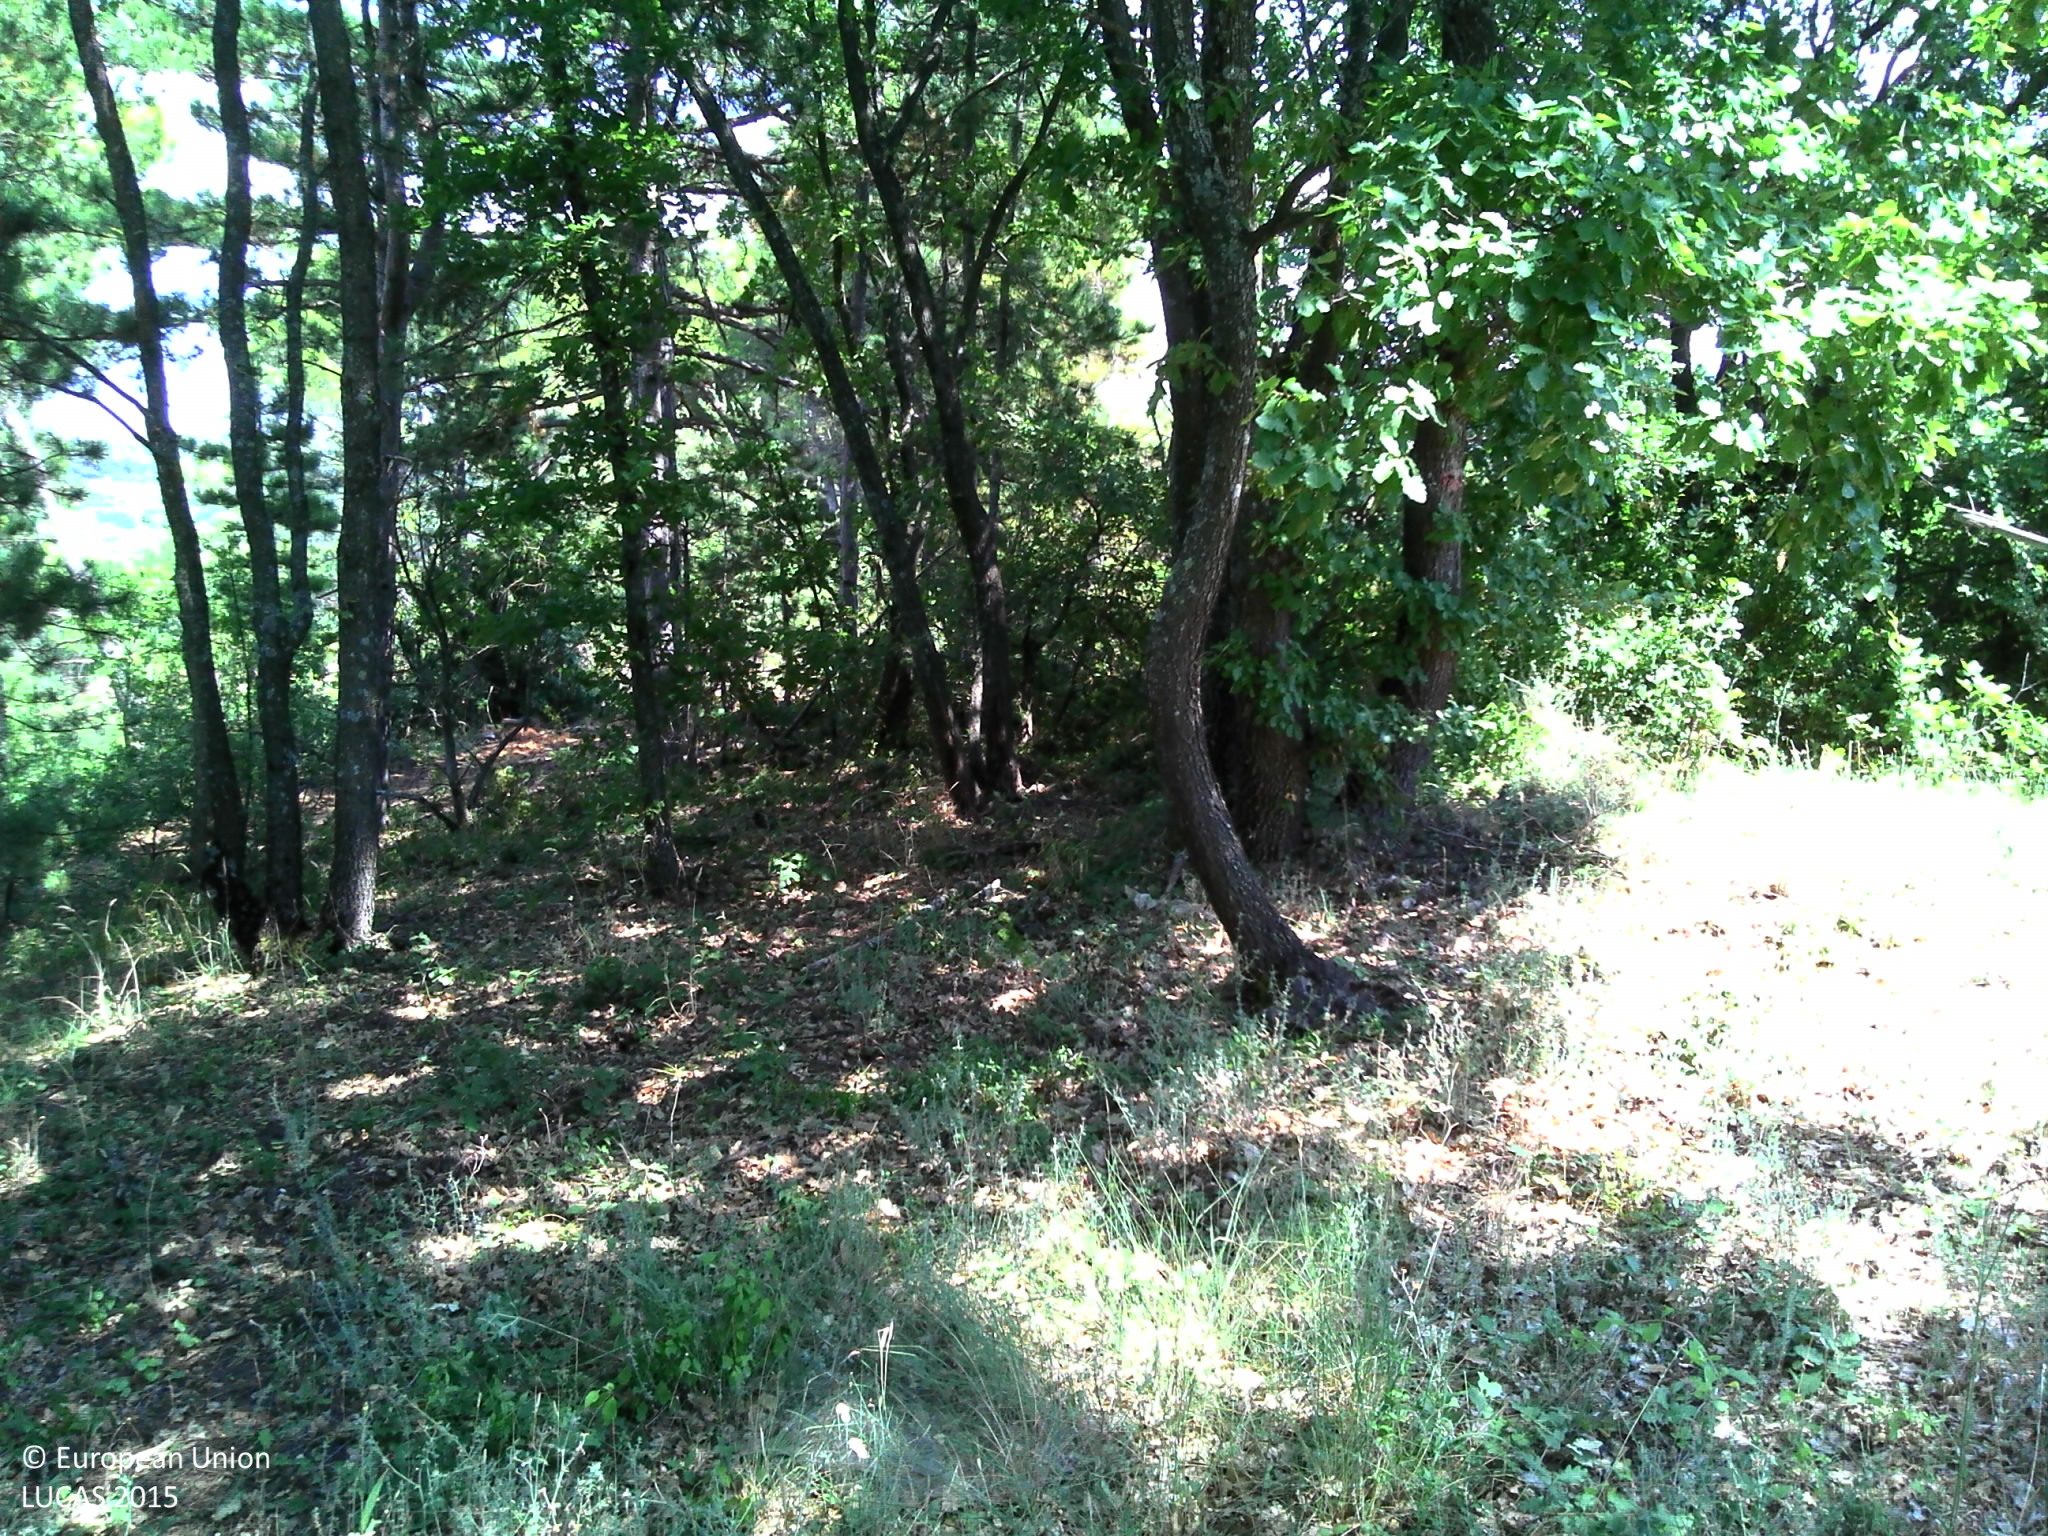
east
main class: Woodland
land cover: Broadleaved woodland
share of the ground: > 75 %
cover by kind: broadleaved forest trees 60 %, herbaceous plants 30 %, coniferous forest trees 5 %, shrubs 5 %
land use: Residential
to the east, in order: Broadleaved woodland; Tracks; Pine dominated mixed woodland; Vineyards; Grass margins; Managed hedges; Tracks; Vineyards; Tracks; Electric lines; Fences; Broadleaved woodland; Fences; Dry stone walls; Tracks
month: August
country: FR
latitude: 43.8475
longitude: 5.3193
